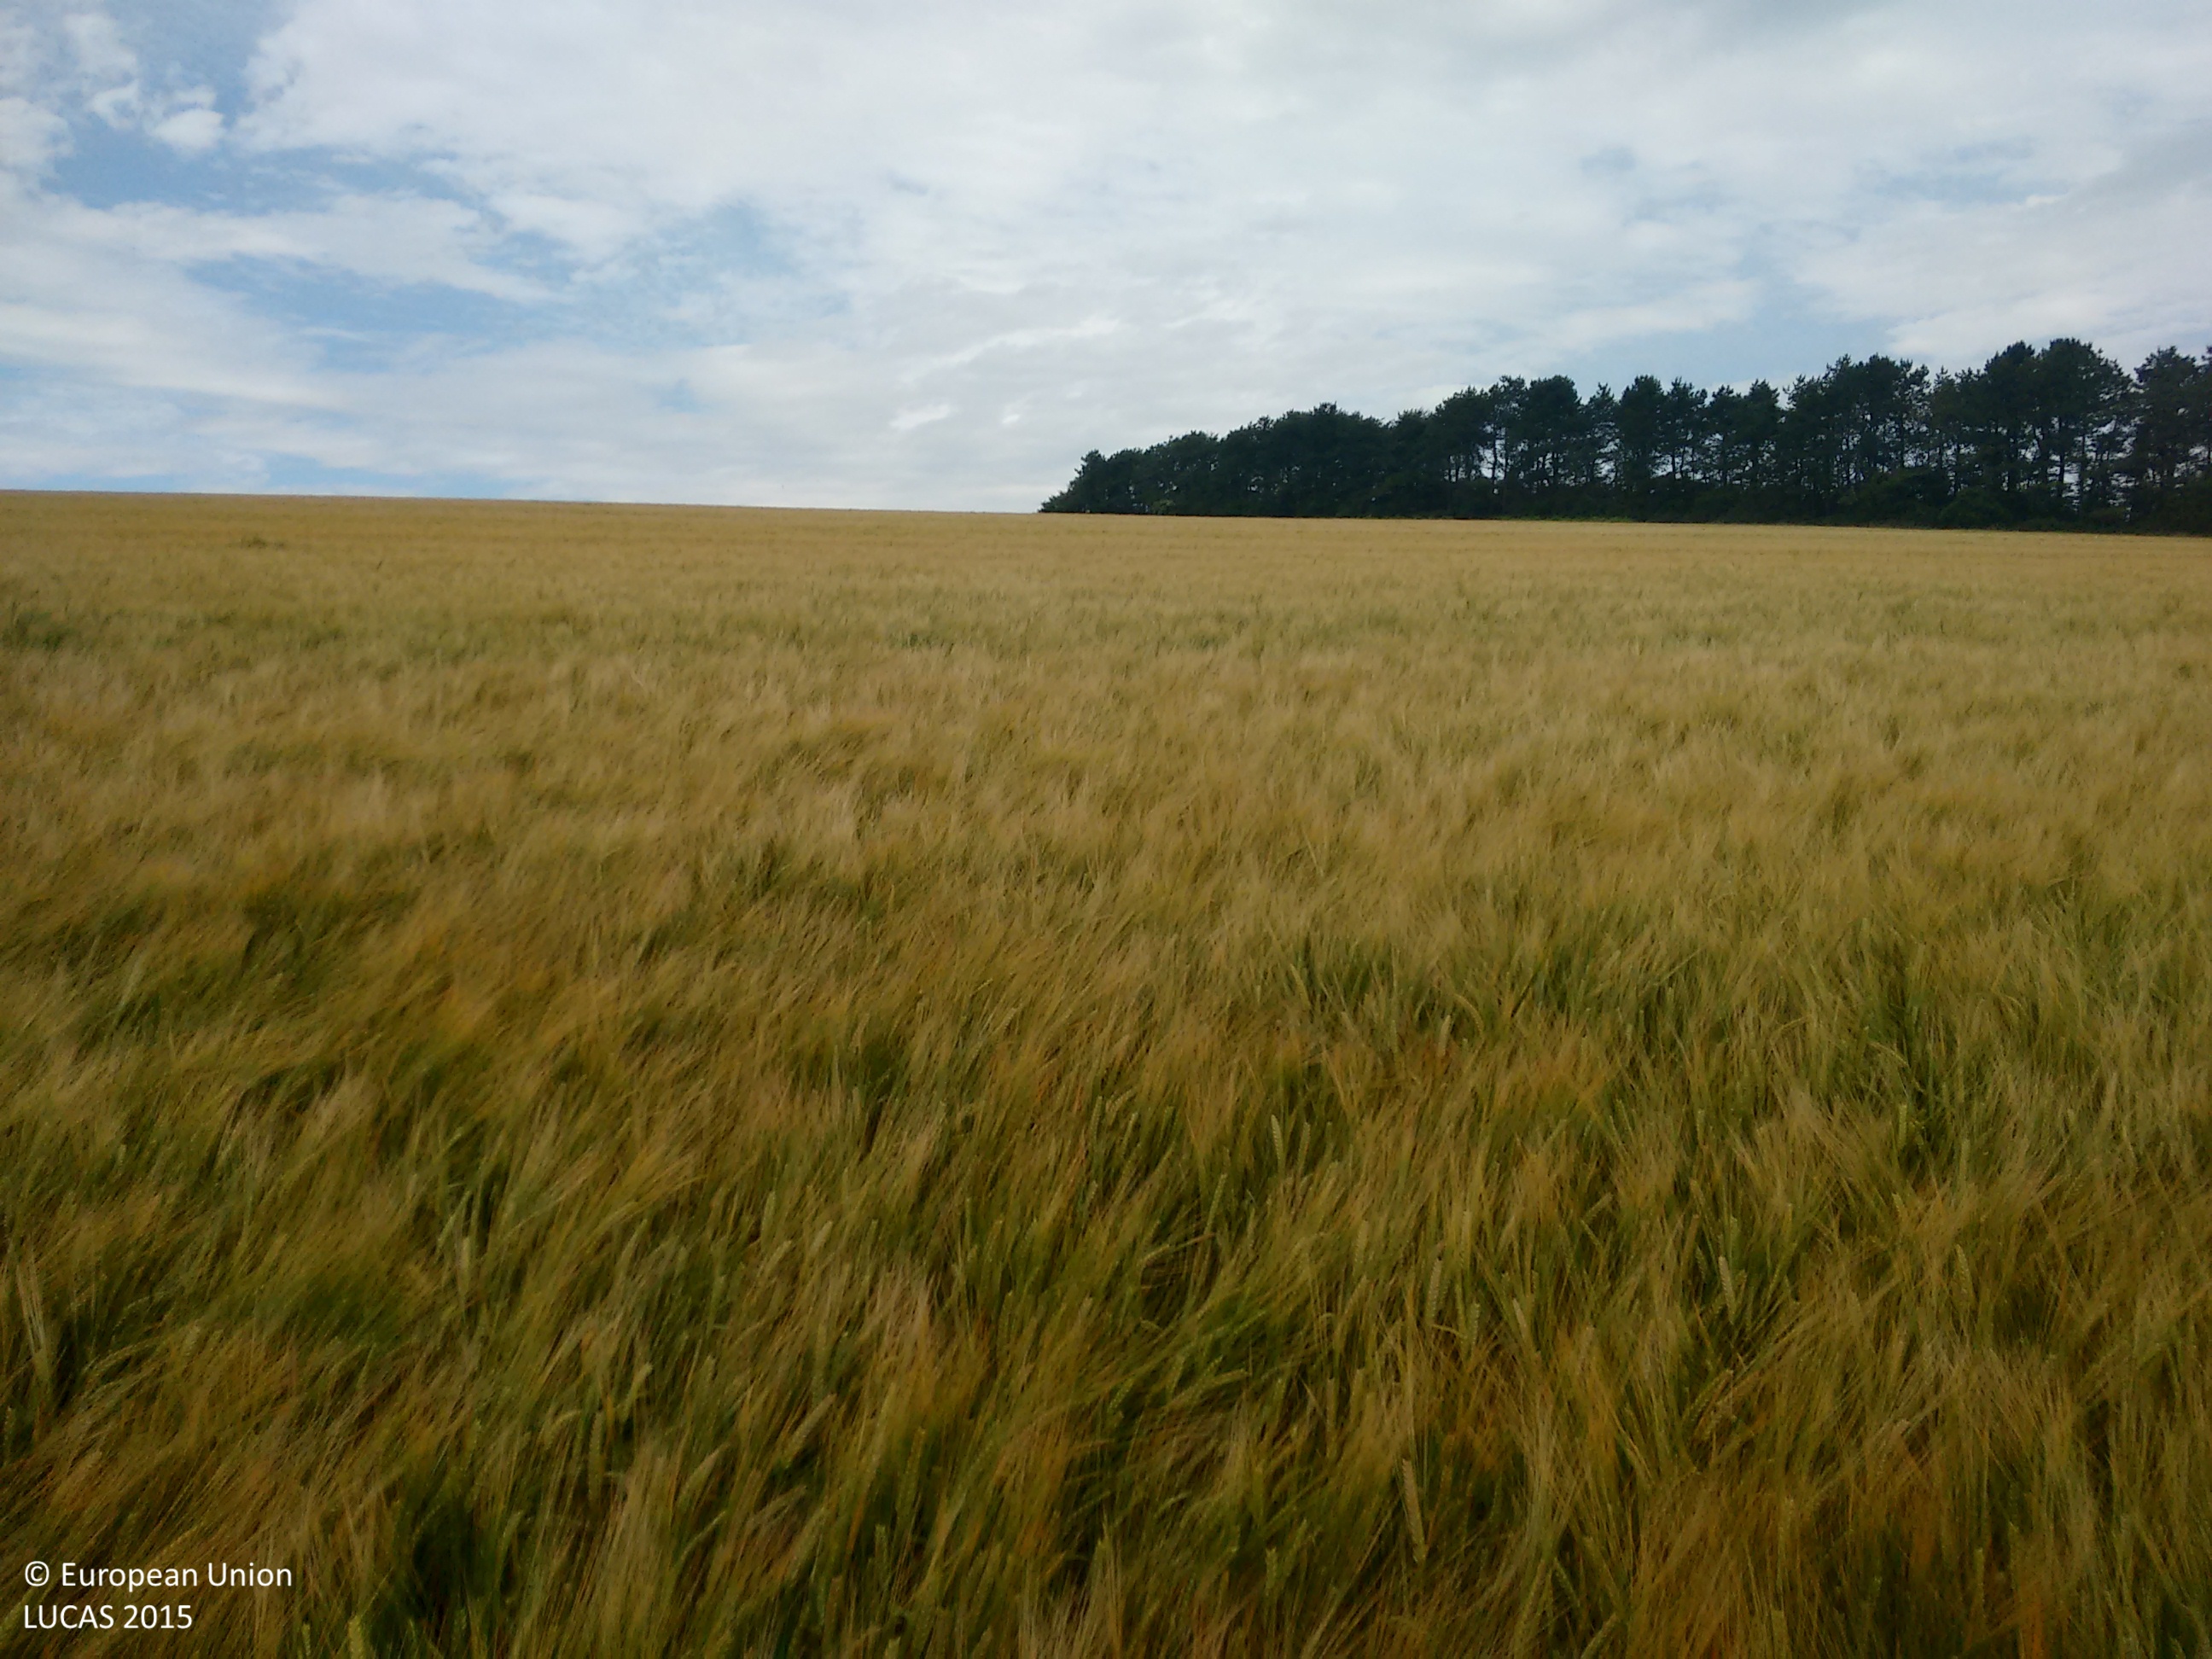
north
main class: Cropland
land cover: Barley
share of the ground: > 75 %
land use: Agriculture (excluding fallow land and kitchen gardens)
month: July
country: GB
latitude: 50.8859
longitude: -0.3997
